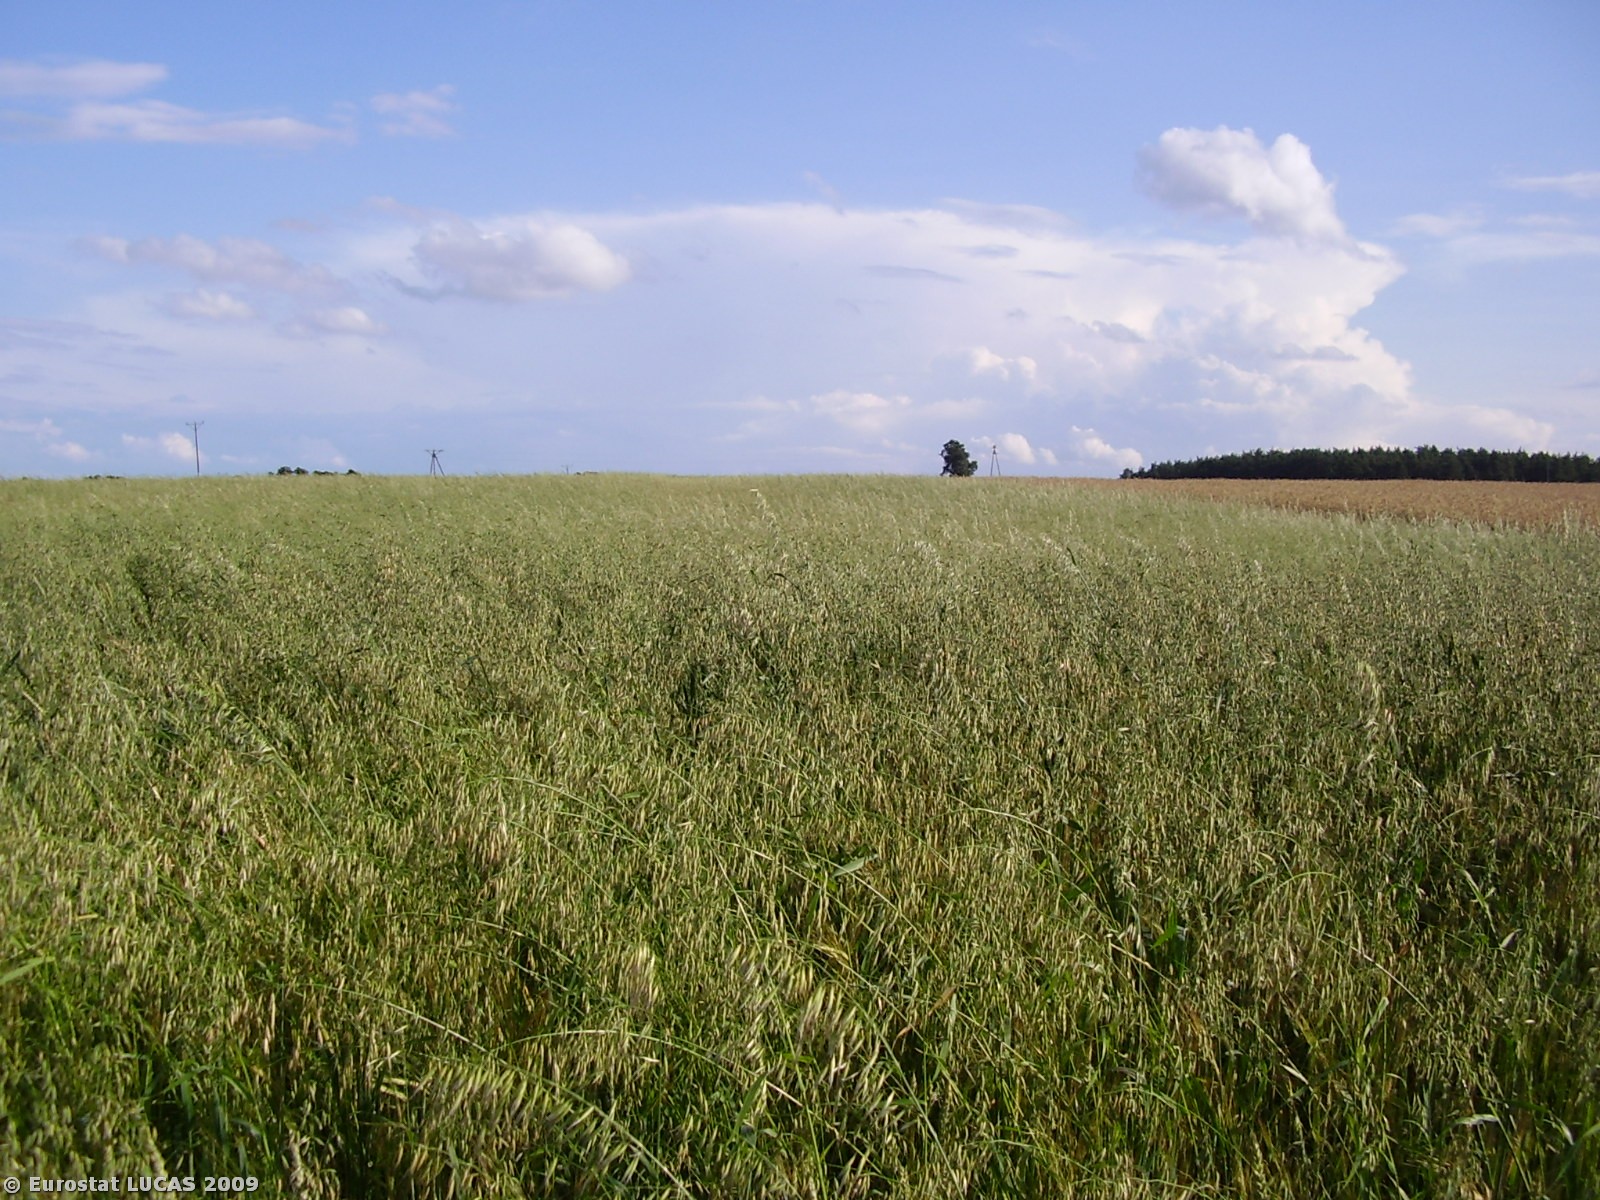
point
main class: Cropland
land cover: Mixed cereals for fodder
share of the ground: > 75 %
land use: Agriculture (excluding fallow land and kitchen gardens)
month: July
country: PL
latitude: 51.2602
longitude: 17.9690
